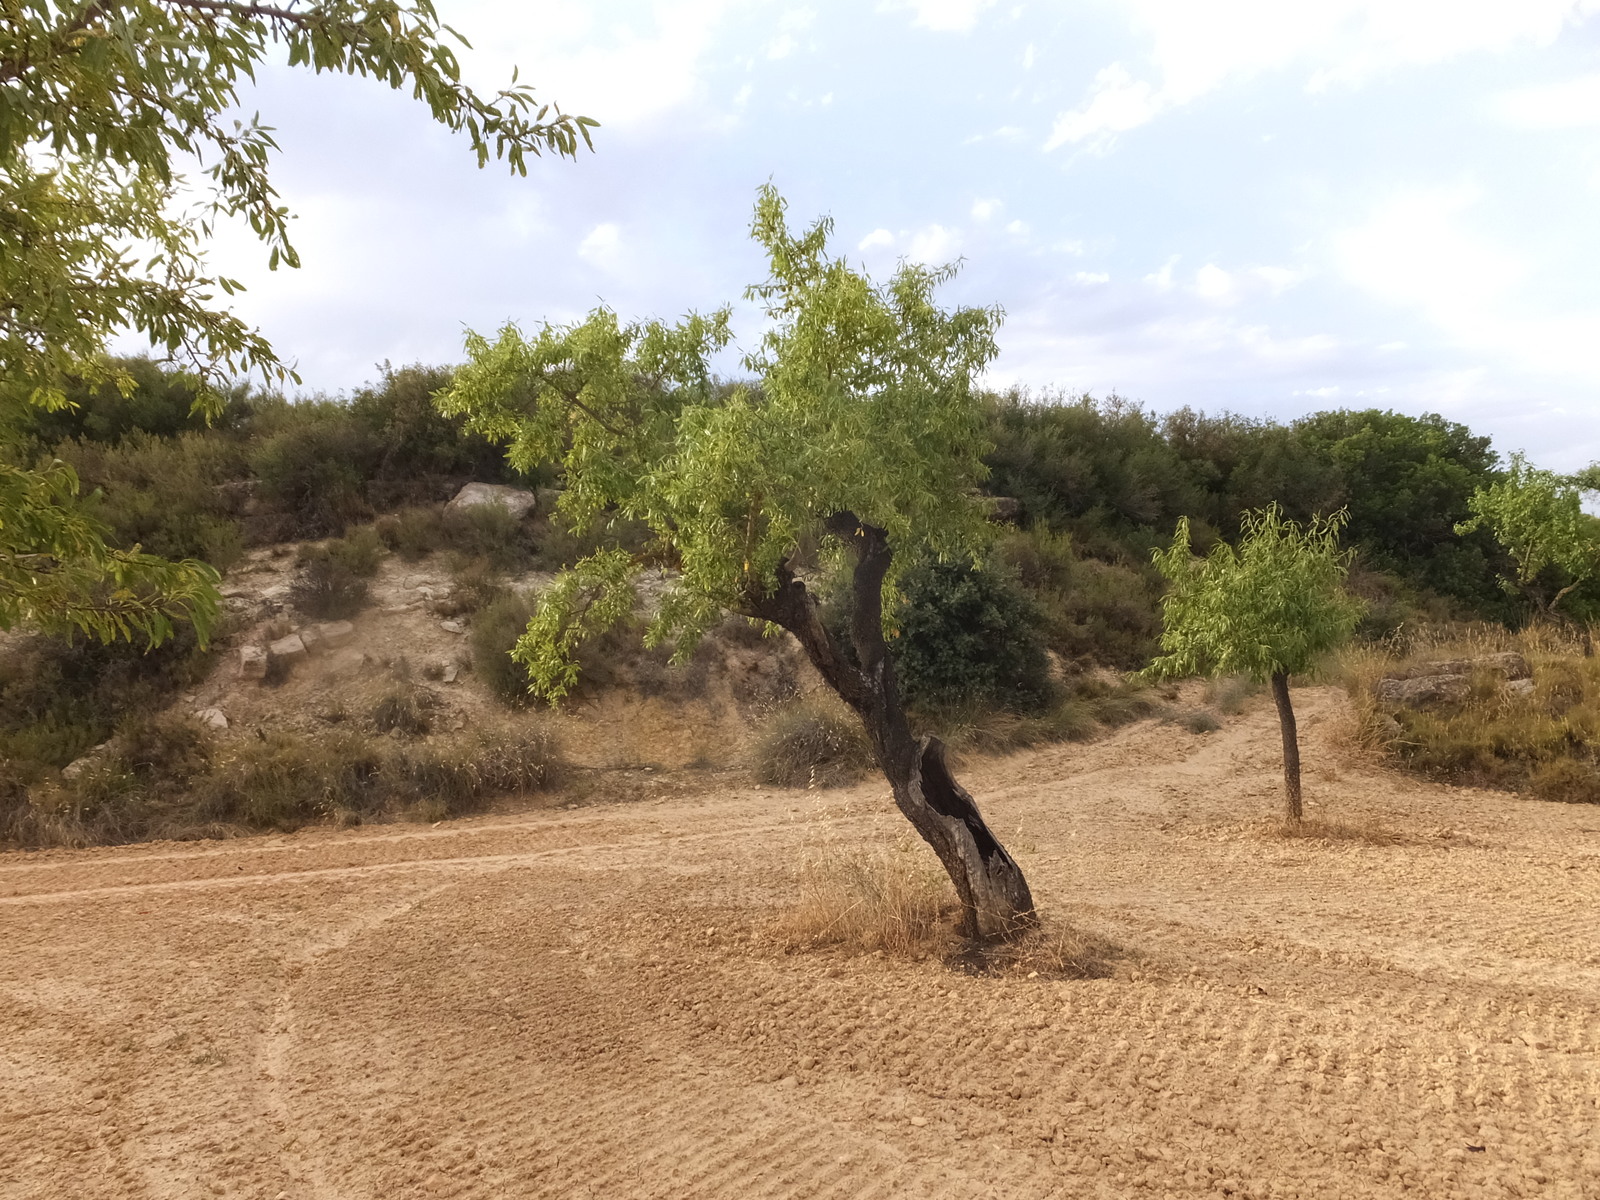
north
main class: Cropland
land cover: Nuts trees
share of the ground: 50 - 75 %
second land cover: Other bare soil
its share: > 75 %
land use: Agriculture (excluding fallow land and kitchen gardens)
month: July
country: ES
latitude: 41.3666
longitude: 0.4608
